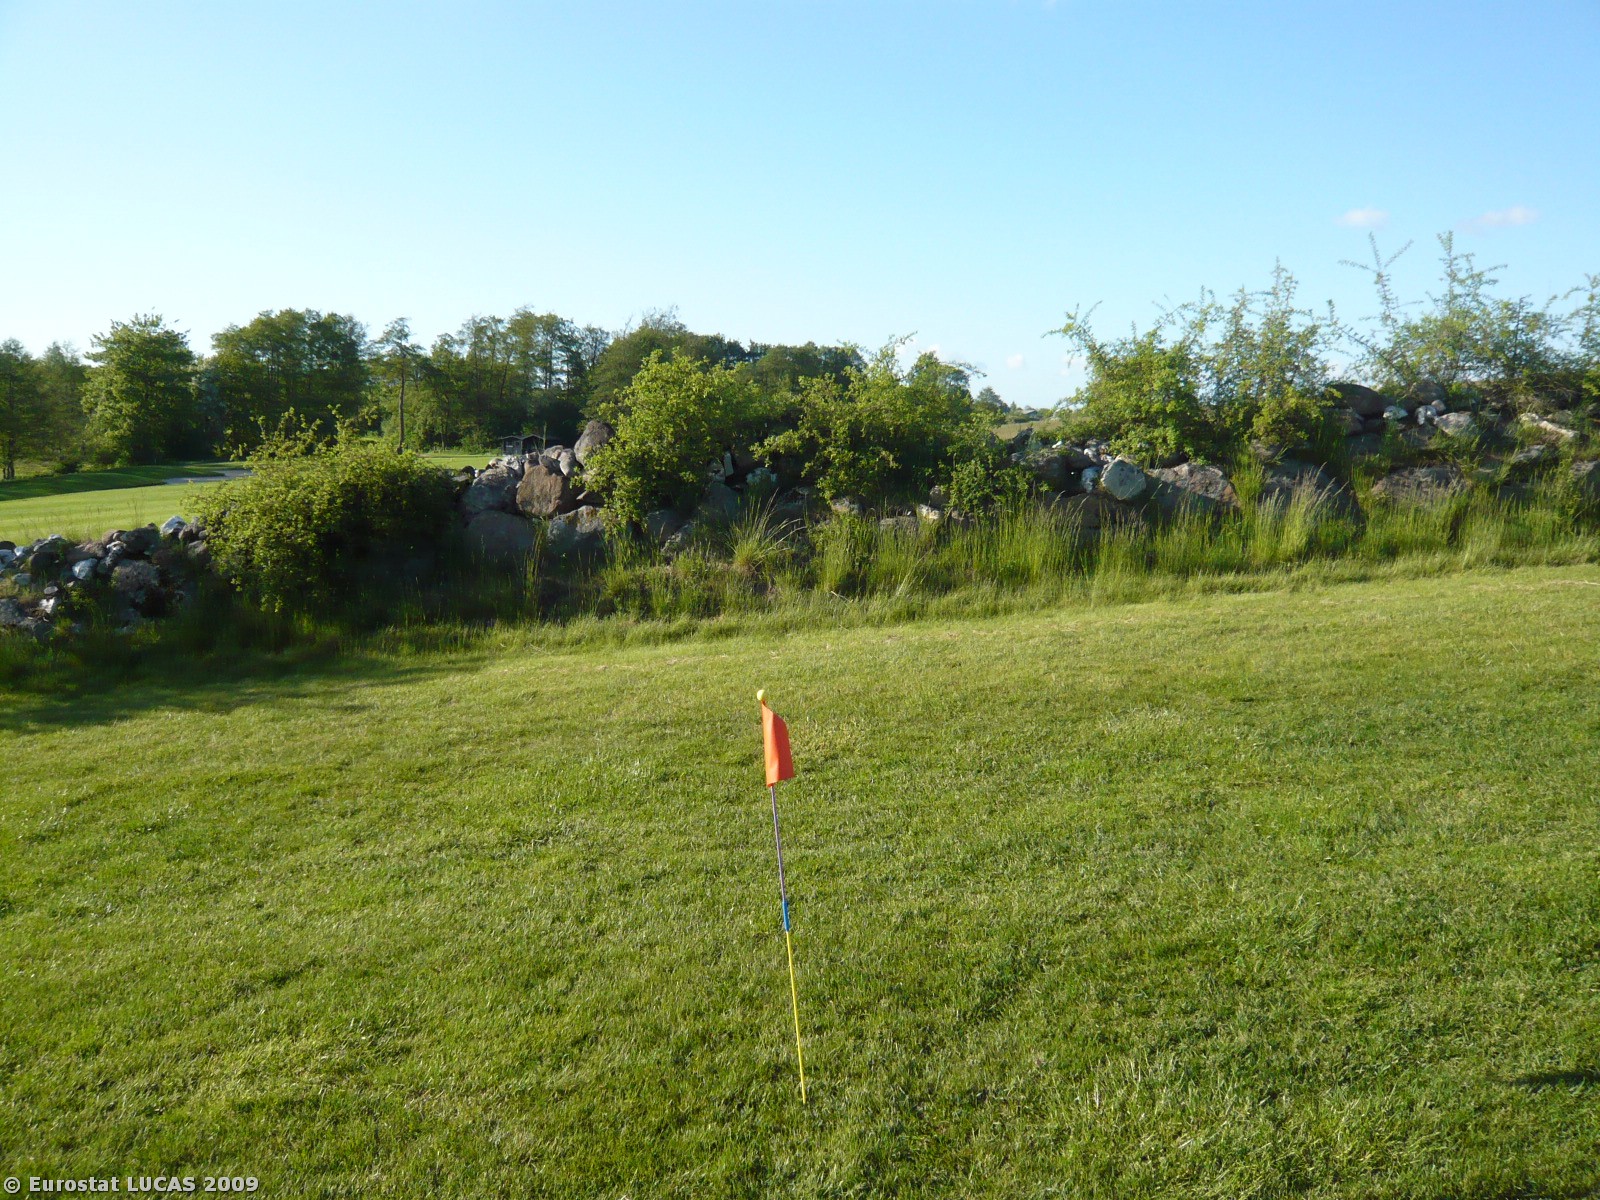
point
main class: Grassland
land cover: Grassland without tree/shrub cover
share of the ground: > 75 %
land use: Sport
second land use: Amenities, museums, leisure
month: May
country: DK
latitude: 55.3872
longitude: 11.5615
